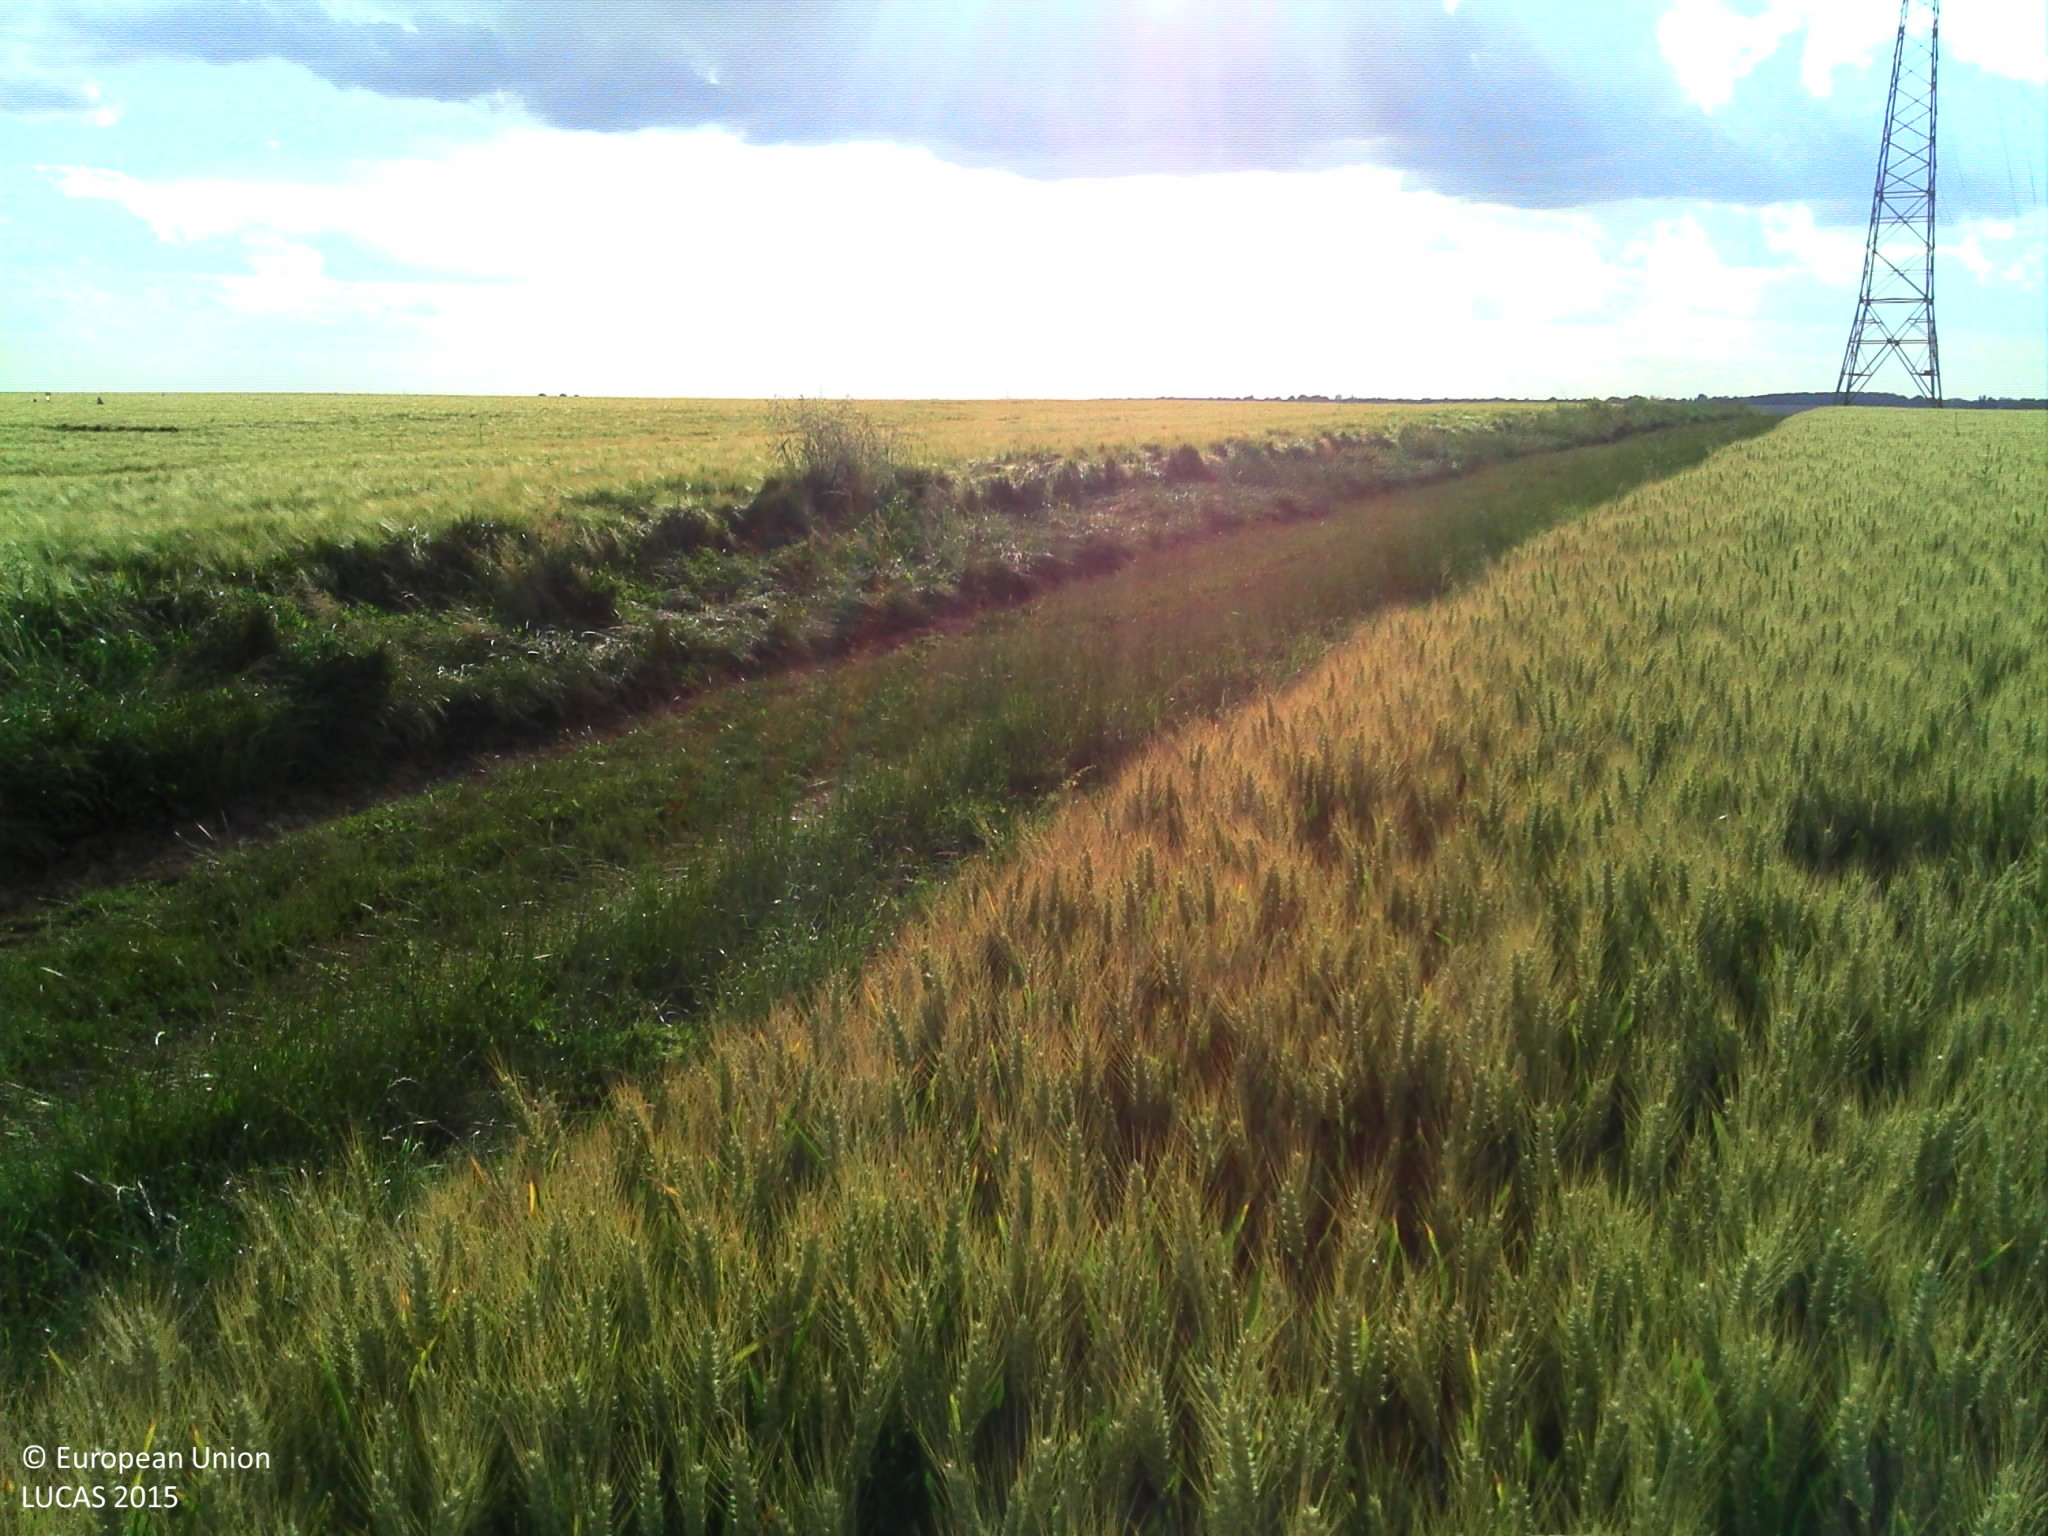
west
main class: Cropland
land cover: Common wheat
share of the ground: > 75 %
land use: Agriculture (excluding fallow land and kitchen gardens)
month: June
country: FR
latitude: 47.3944
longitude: 3.1189
